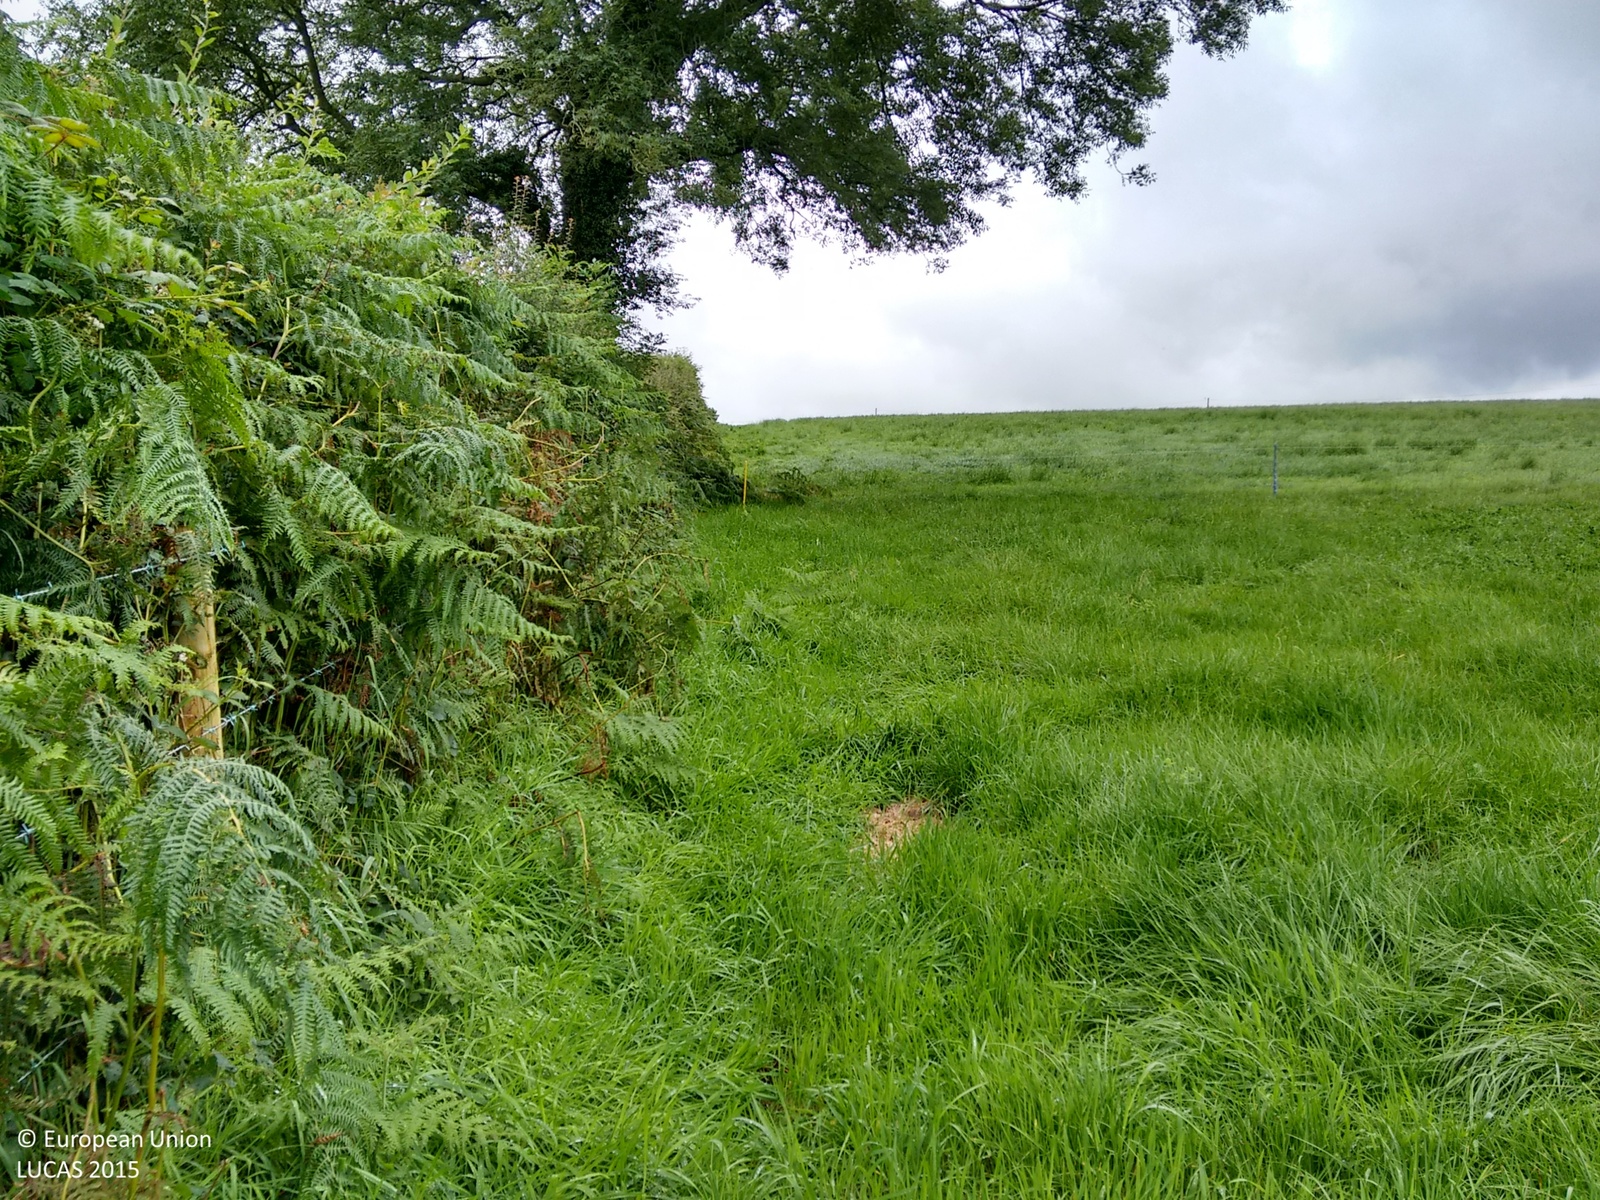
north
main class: Grassland
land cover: Grassland without tree/shrub cover
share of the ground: > 75 %
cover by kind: herbaceous plants 100 %
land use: Agriculture (excluding fallow land and kitchen gardens)
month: August
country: GB
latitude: 51.8569
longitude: -4.8508
